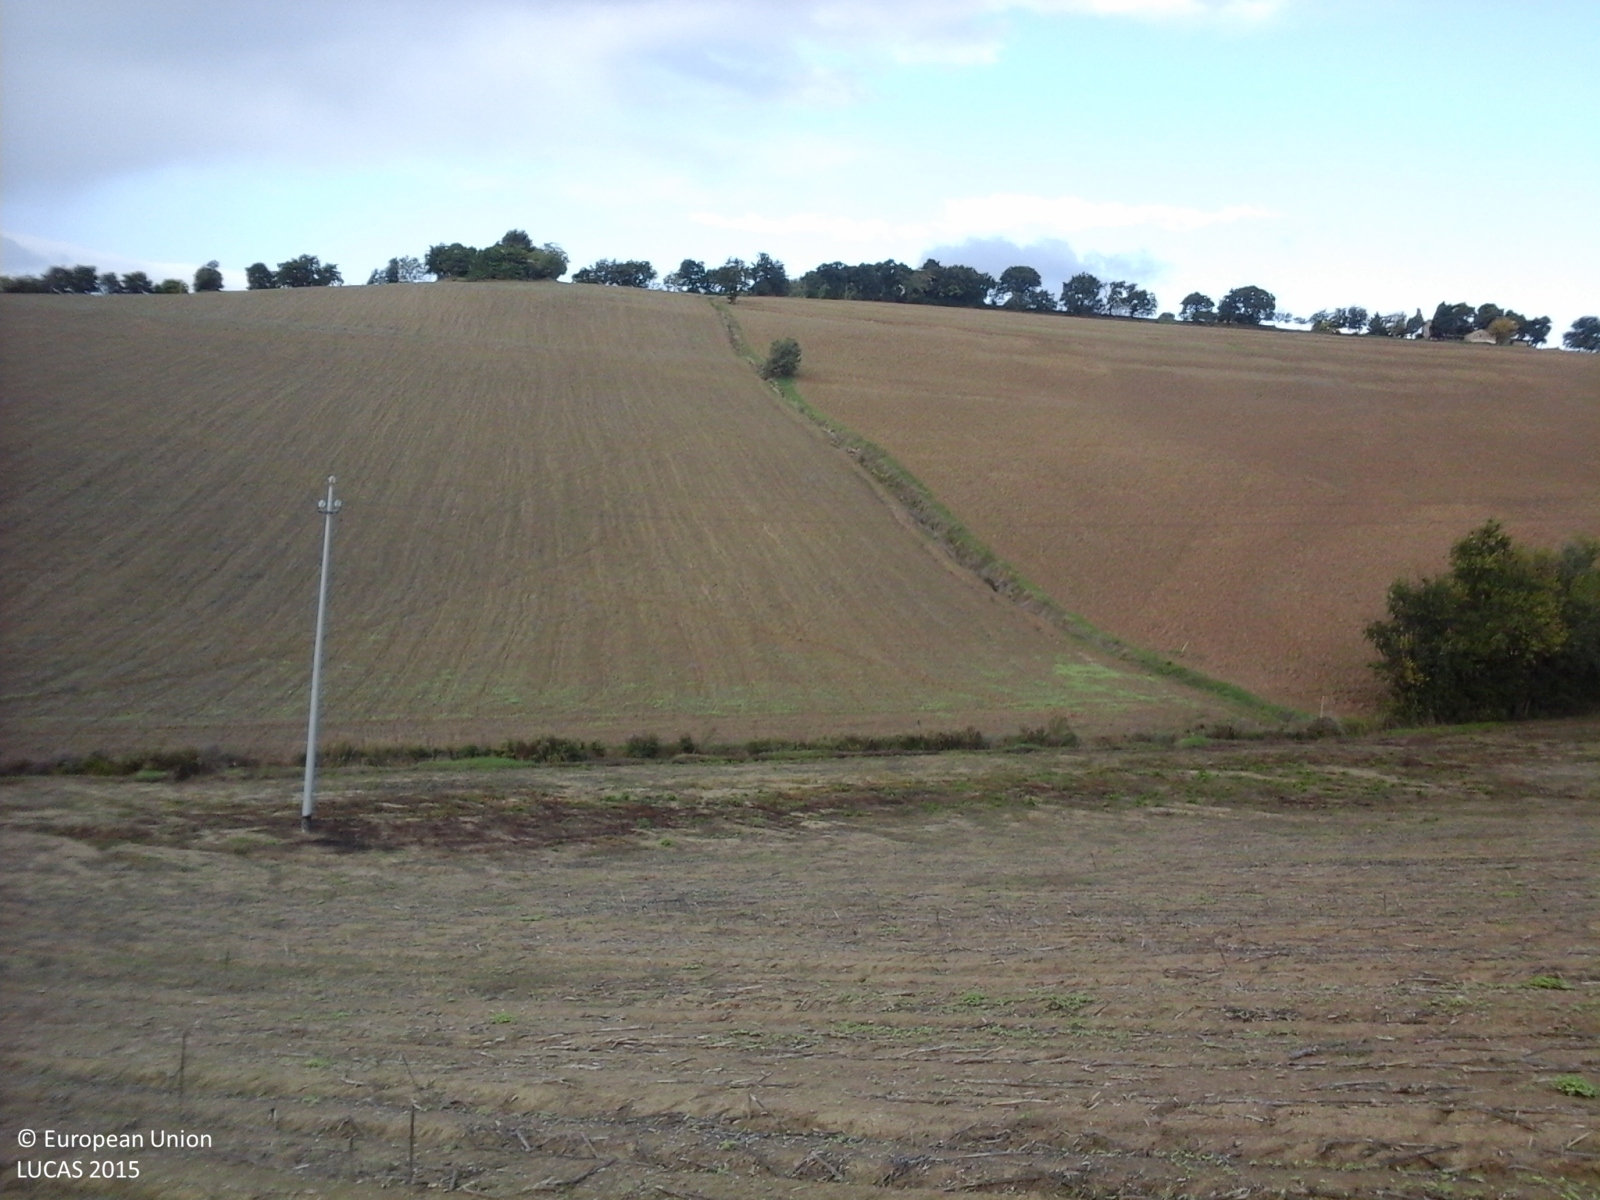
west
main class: Cropland
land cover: Sunflower
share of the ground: < 10 %
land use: Agriculture (excluding fallow land and kitchen gardens)
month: October
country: IT
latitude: 43.6332
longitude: 13.2025
